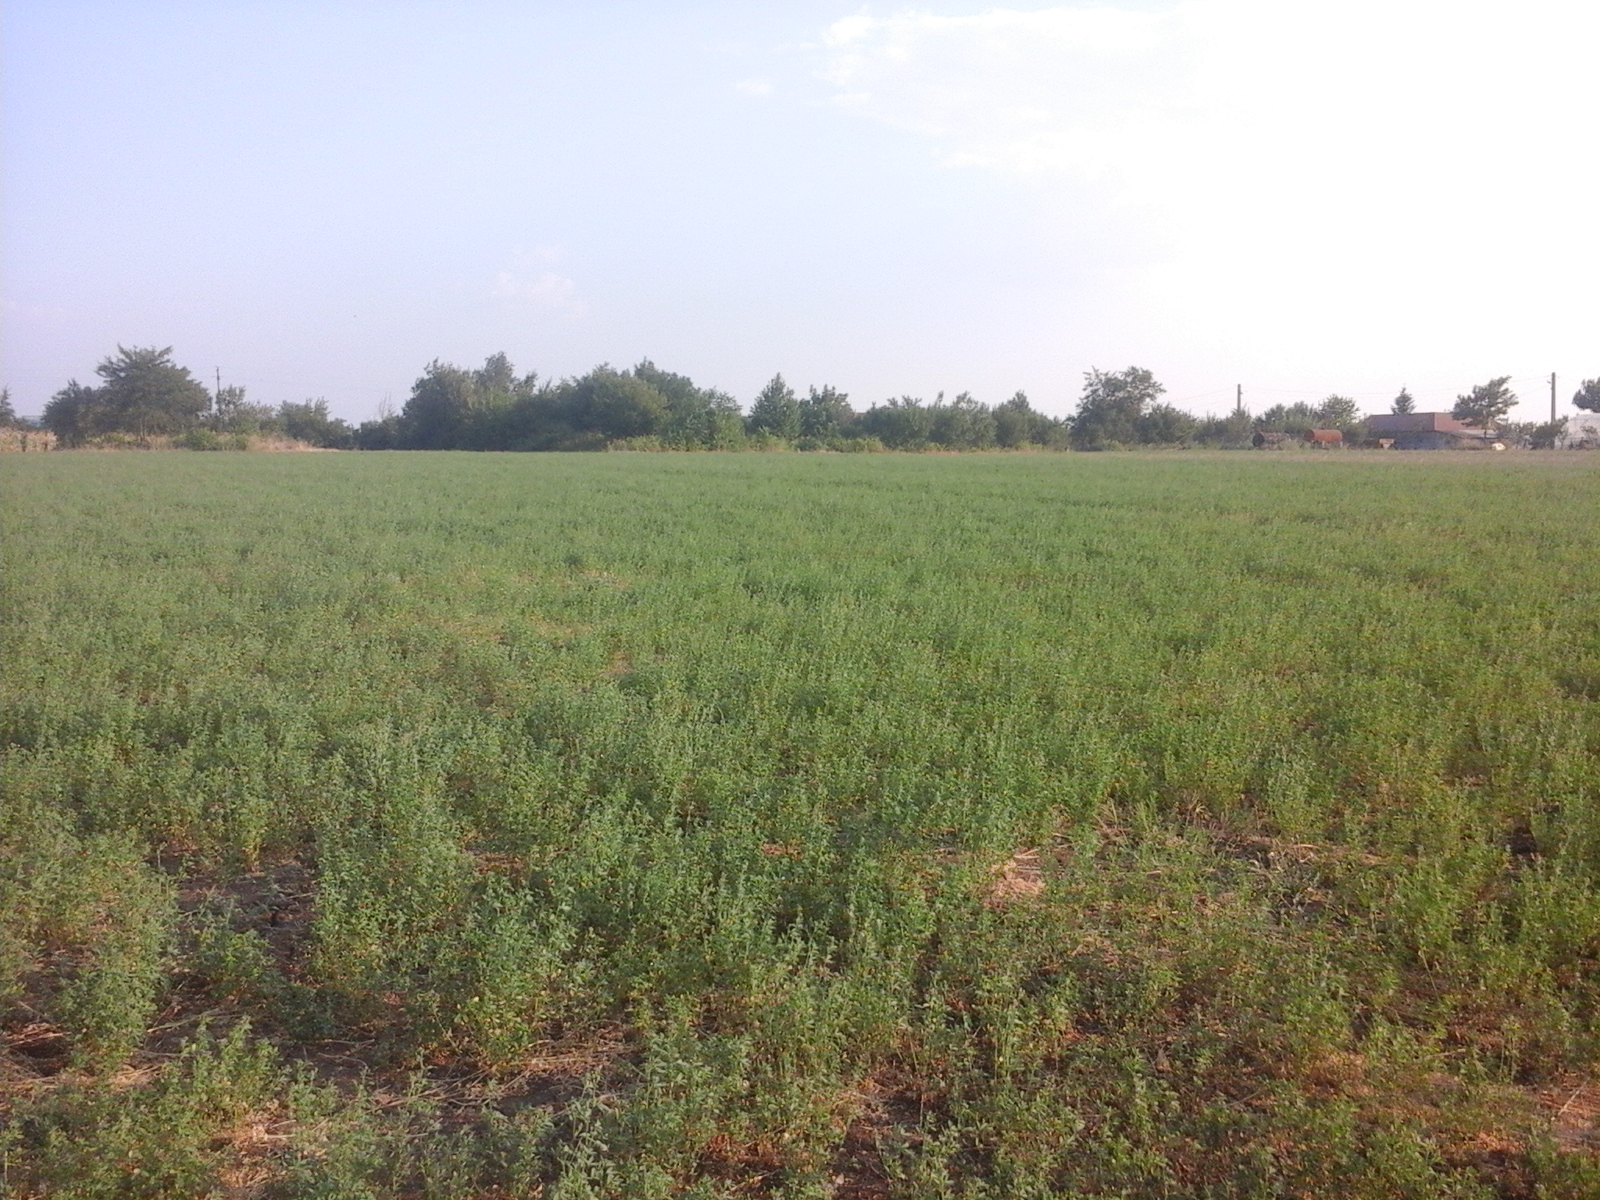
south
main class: Cropland
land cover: Lucerne
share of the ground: > 75 %
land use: Agriculture (excluding fallow land and kitchen gardens)
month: August
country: RO
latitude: 44.1444
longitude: 23.4636
